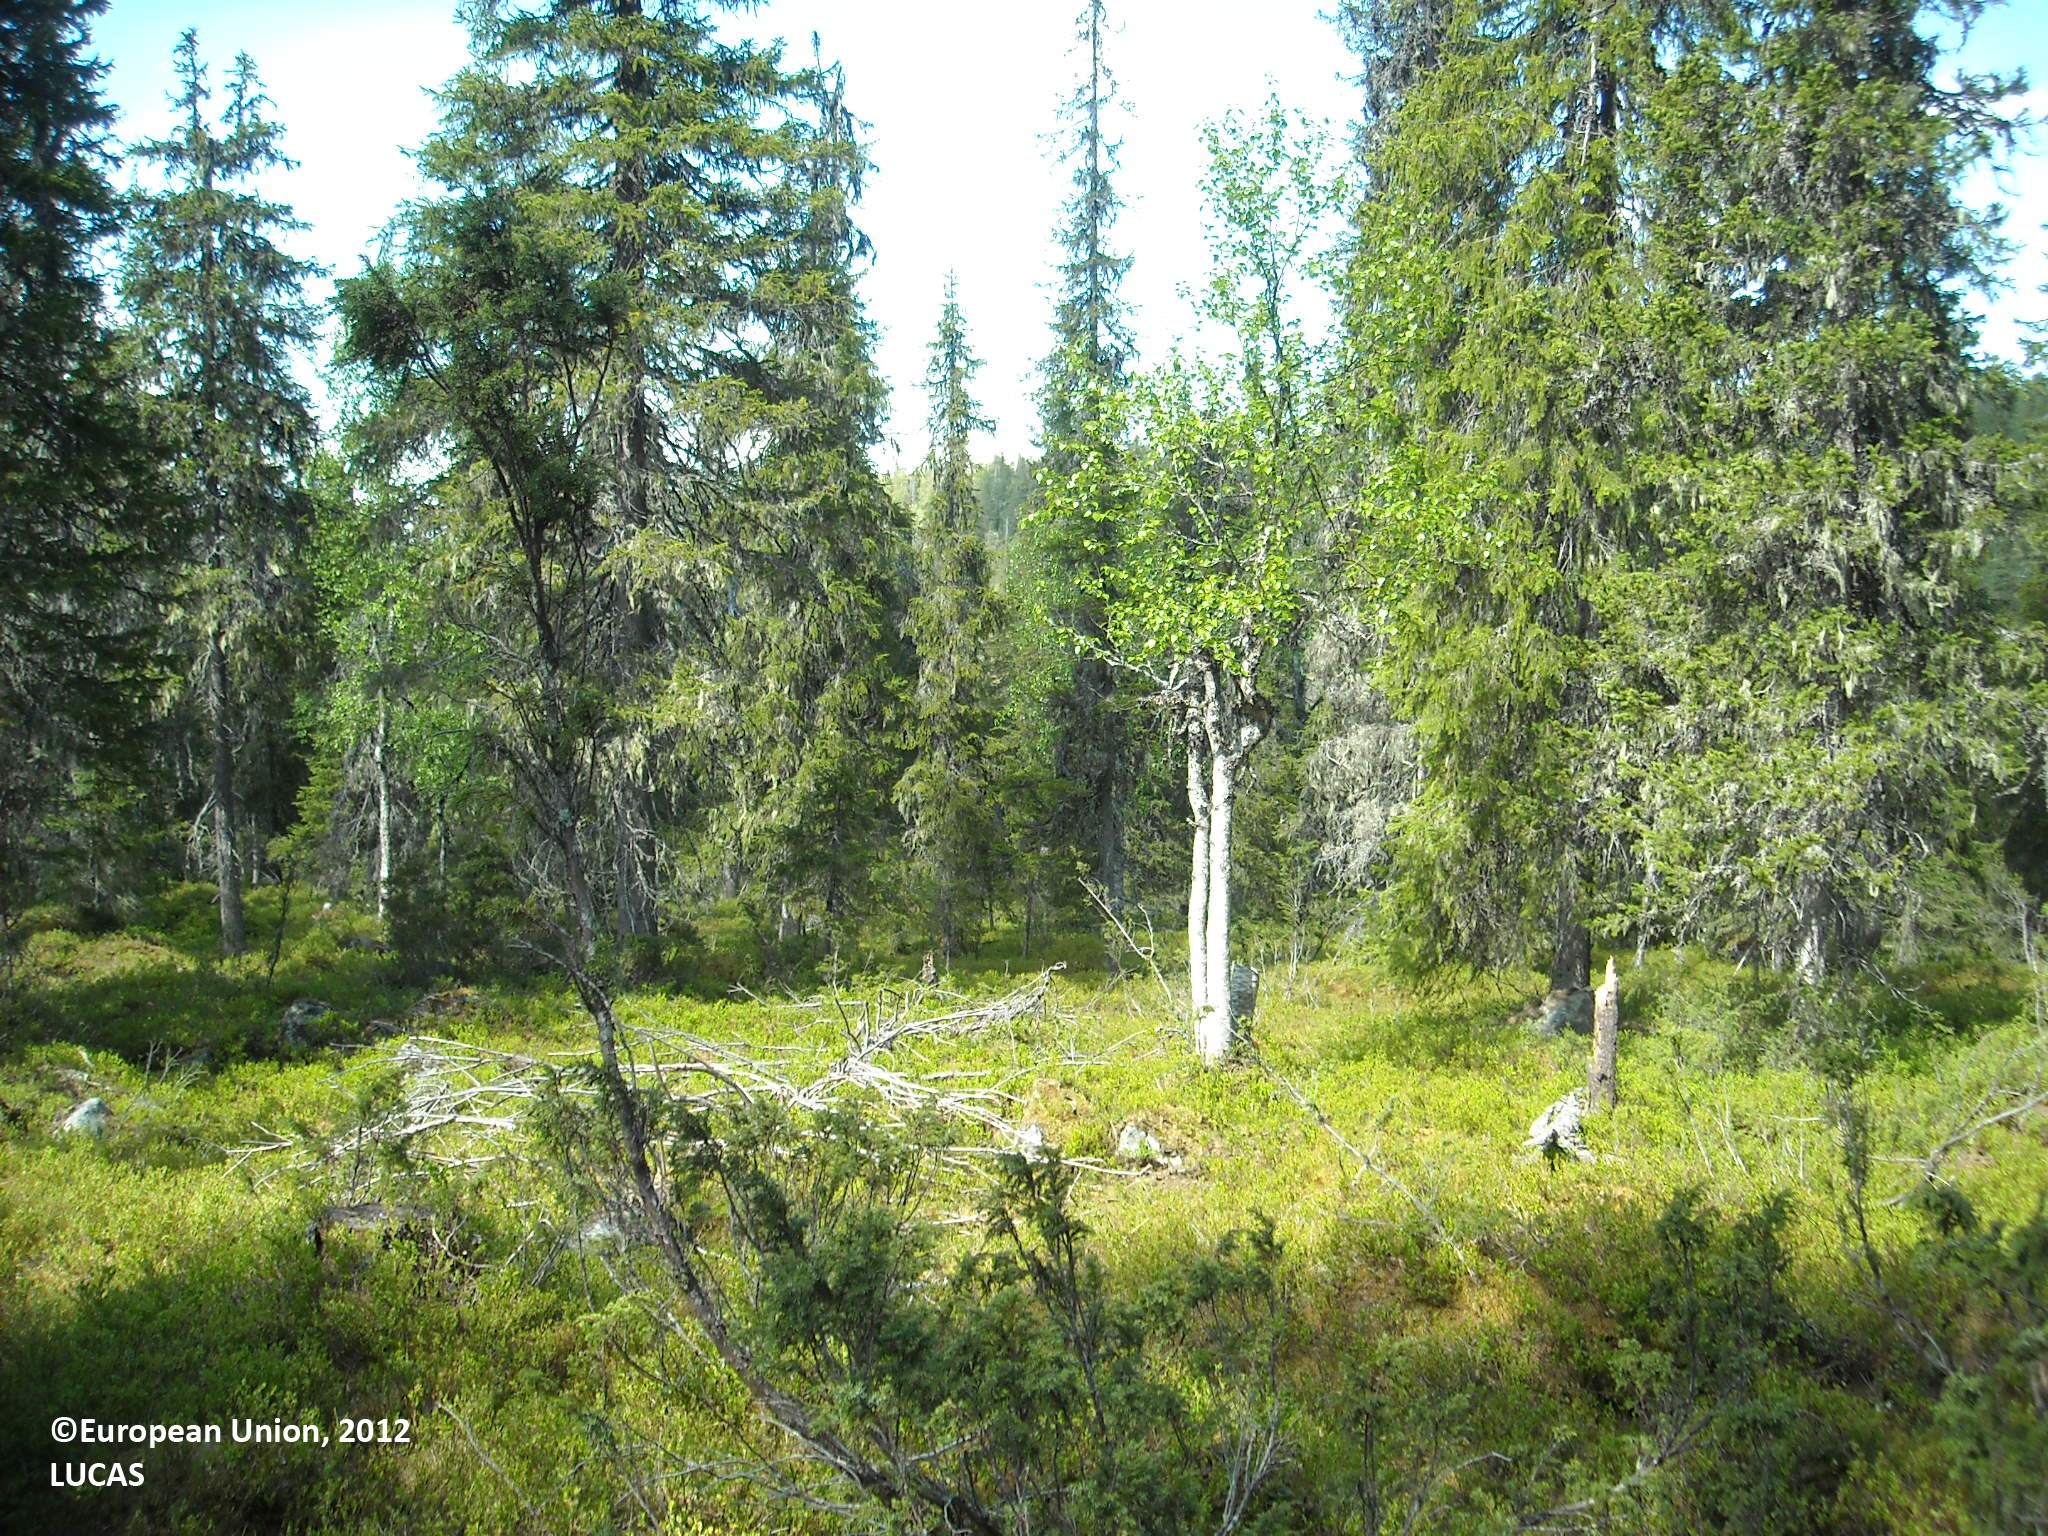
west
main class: Woodland
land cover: Spruce dominated coniferous woodland
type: boreal forest
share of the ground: > 75 %
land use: Forestry
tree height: > 5 m
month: June
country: FI
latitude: 65.7817
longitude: 27.9892
